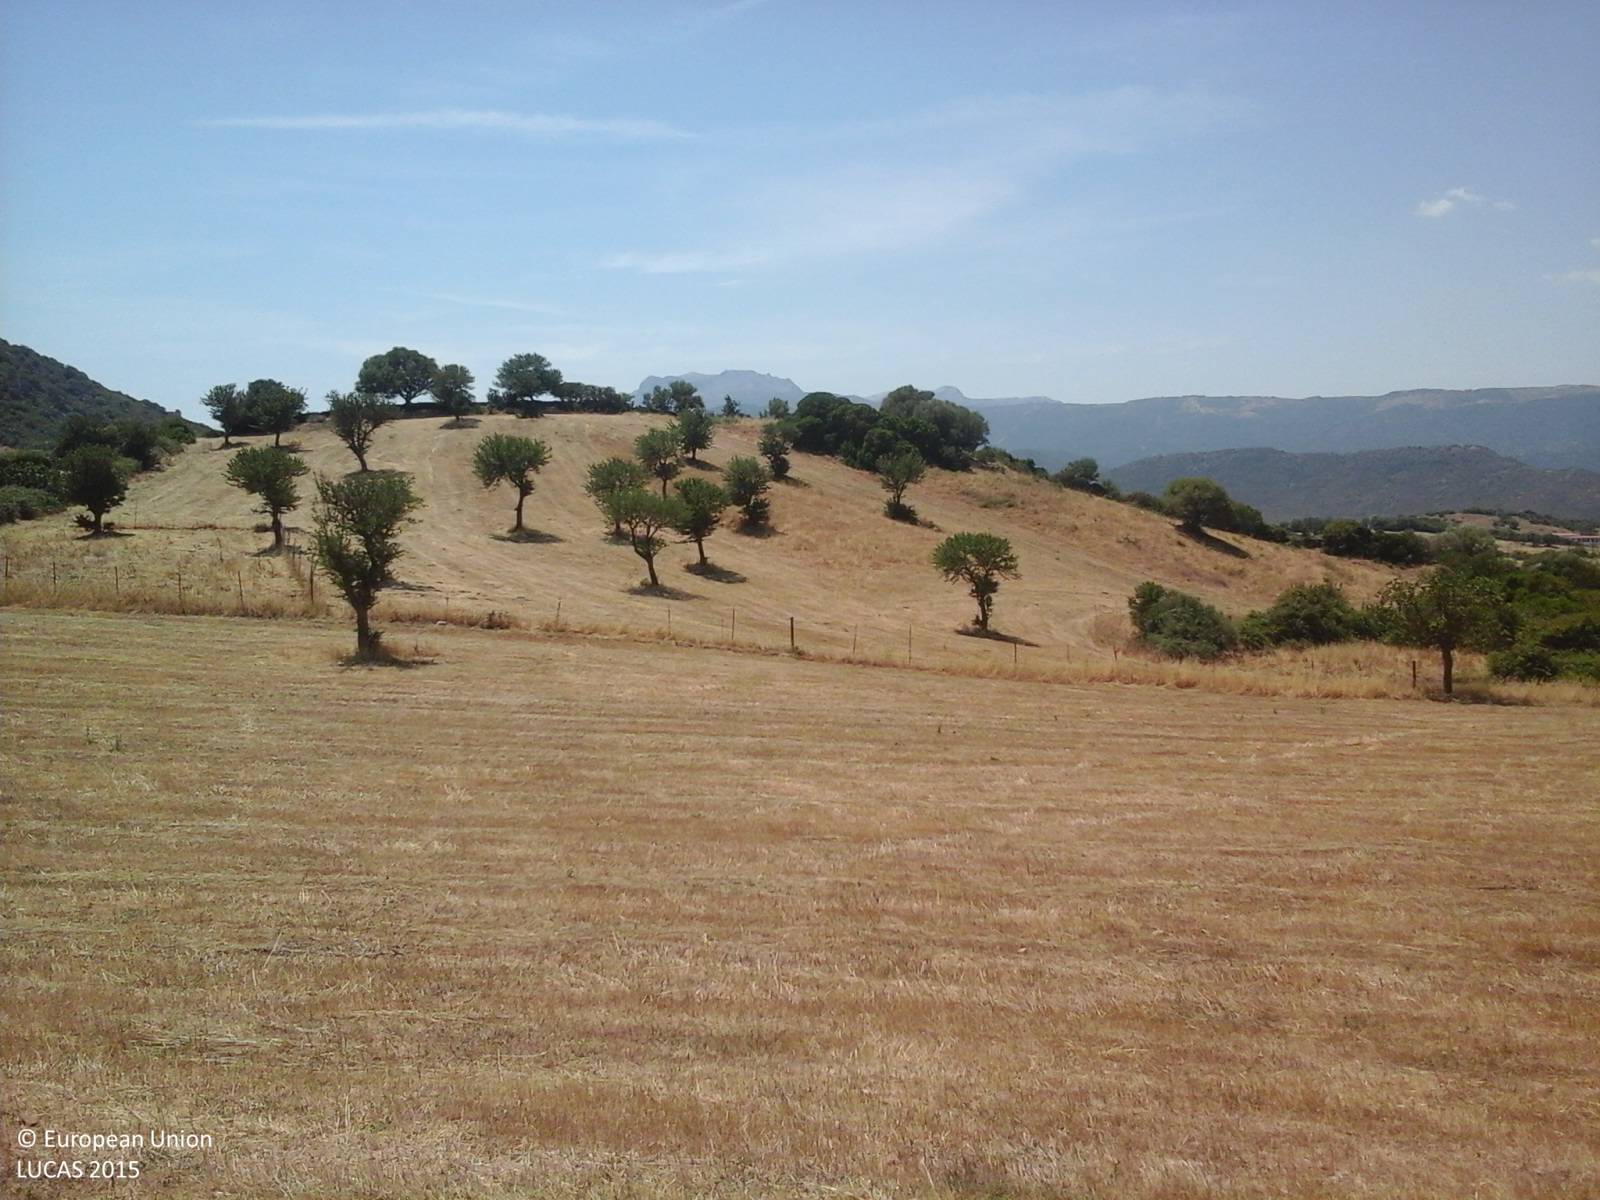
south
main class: Grassland
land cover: Grassland without tree/shrub cover
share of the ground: > 75 %
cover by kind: herbaceous plants 95 %, unconsolidated bare surface 5 %
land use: Agriculture (excluding fallow land and kitchen gardens)
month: June
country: IT
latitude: 40.6648
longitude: 9.6351
